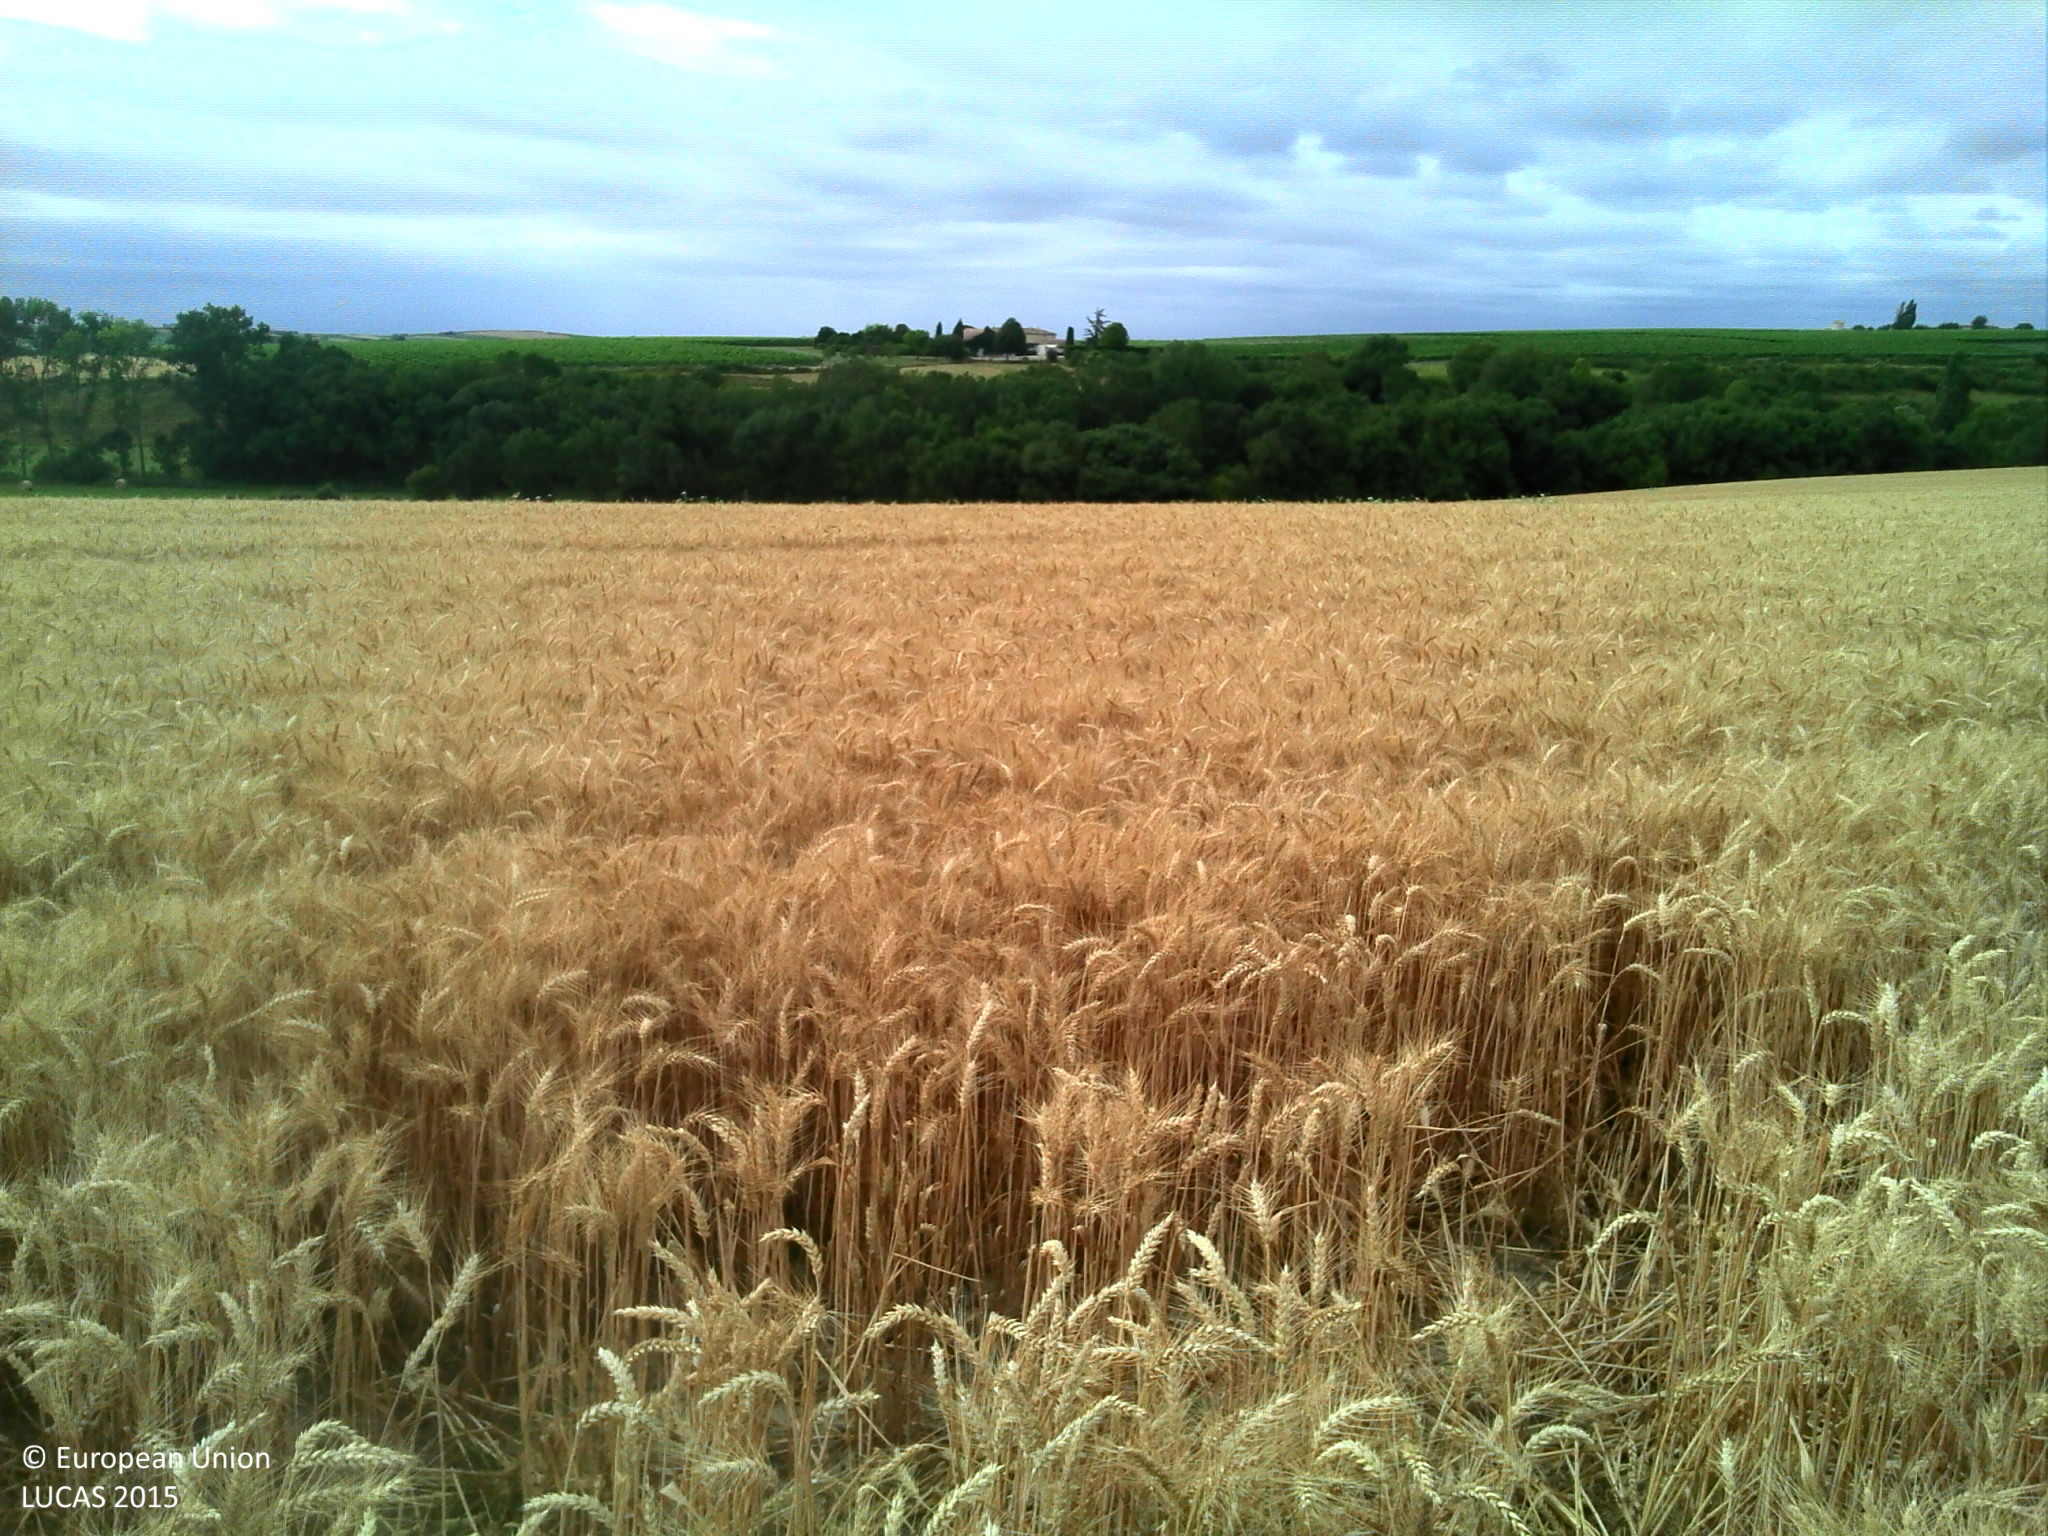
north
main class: Cropland
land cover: Durum wheat
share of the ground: > 75 %
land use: Agriculture (excluding fallow land and kitchen gardens)
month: July
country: FR
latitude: 45.5079
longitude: -0.8405
